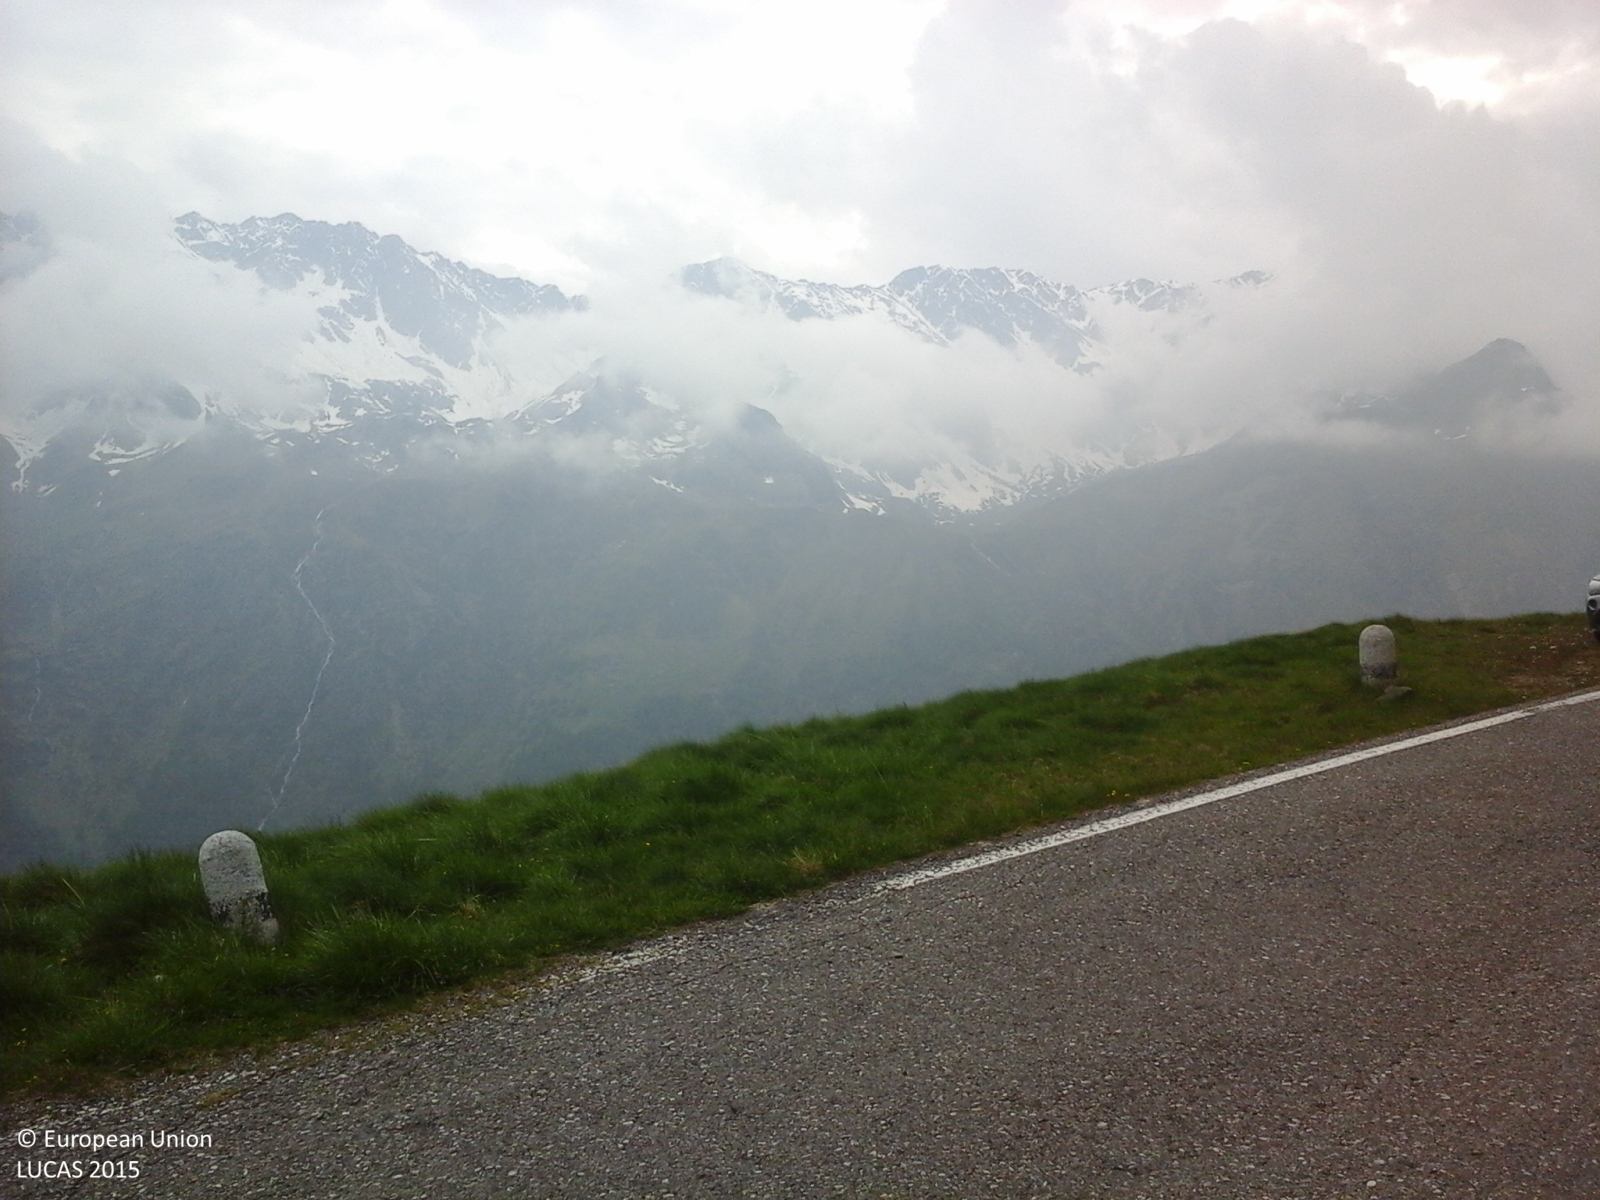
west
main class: Grassland
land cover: Grassland without tree/shrub cover
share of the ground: > 75 %
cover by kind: herbaceous plants 100 %
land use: Semi-natural and natural areas not in use
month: June
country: IT
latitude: 46.3140
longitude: 10.5058
